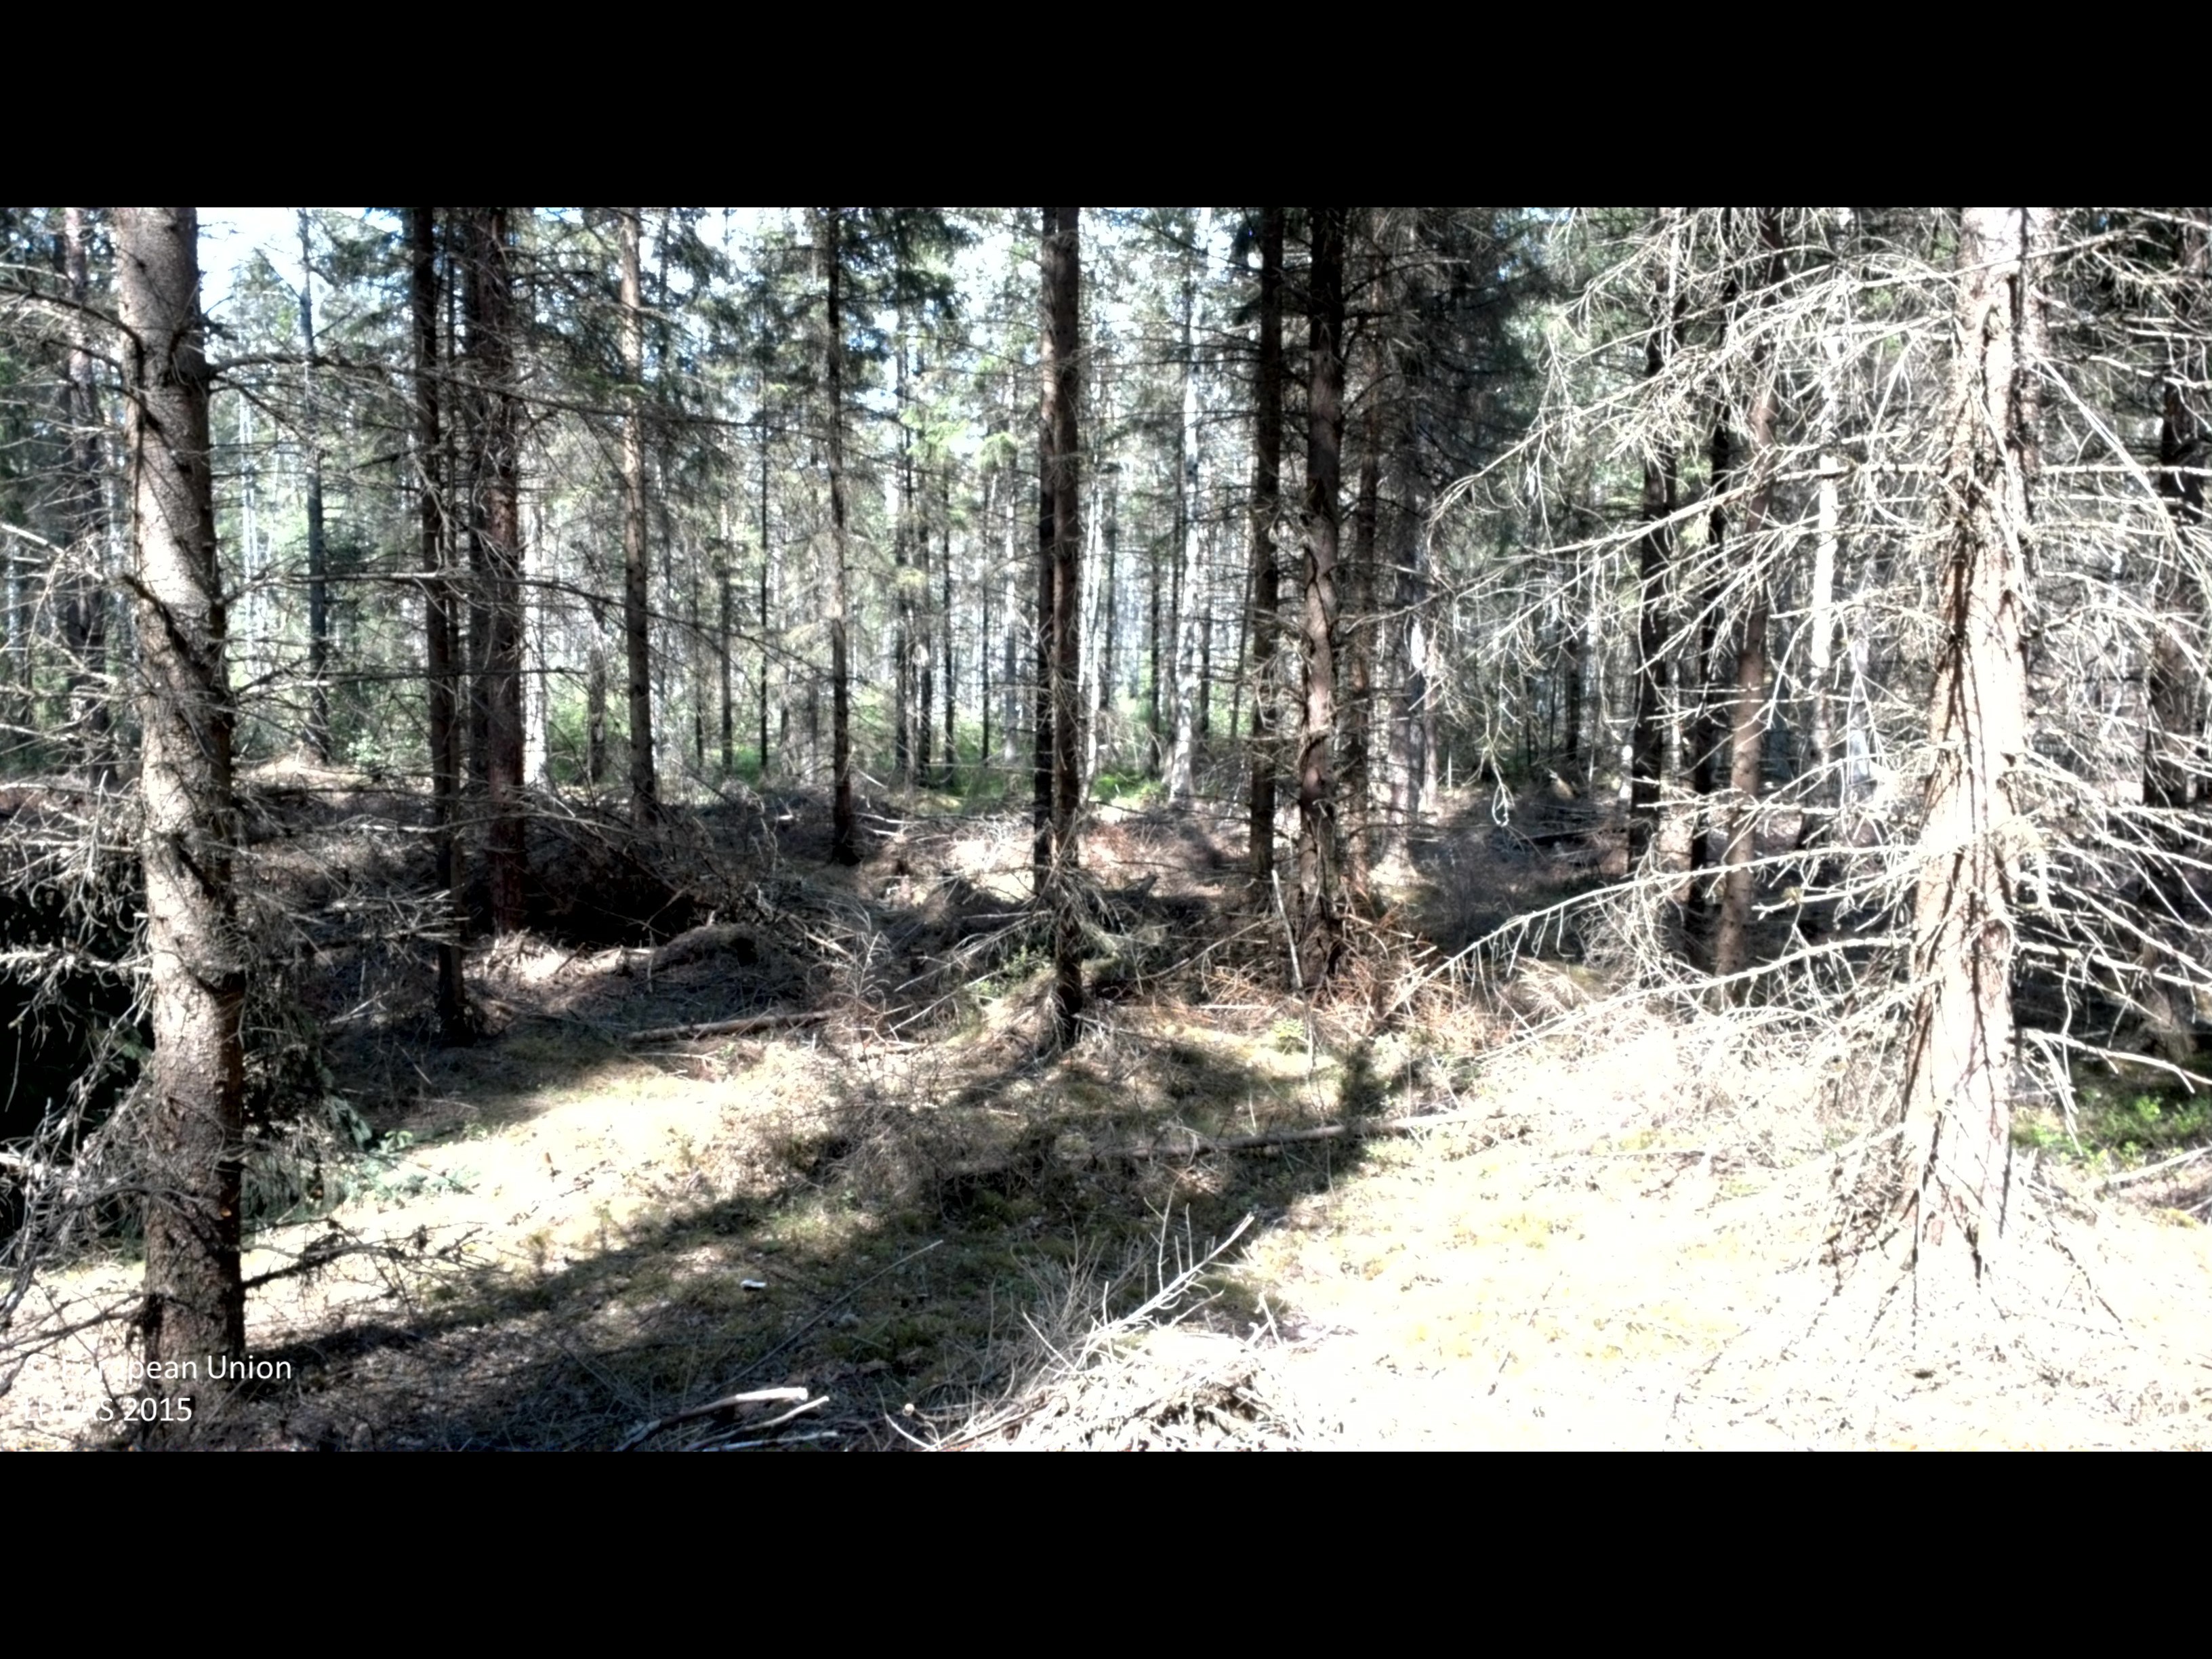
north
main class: Woodland
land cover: Spruce dominated coniferous woodland
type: boreal forest
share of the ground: 50 - 75 %
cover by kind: coniferous forest trees 65 %, lichens and mosses 20 %, unconsolidated bare surface 10 %, broadleaved forest trees 5 %
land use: Forestry
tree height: > 5 m
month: July
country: SE
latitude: 56.4411
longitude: 14.2633
